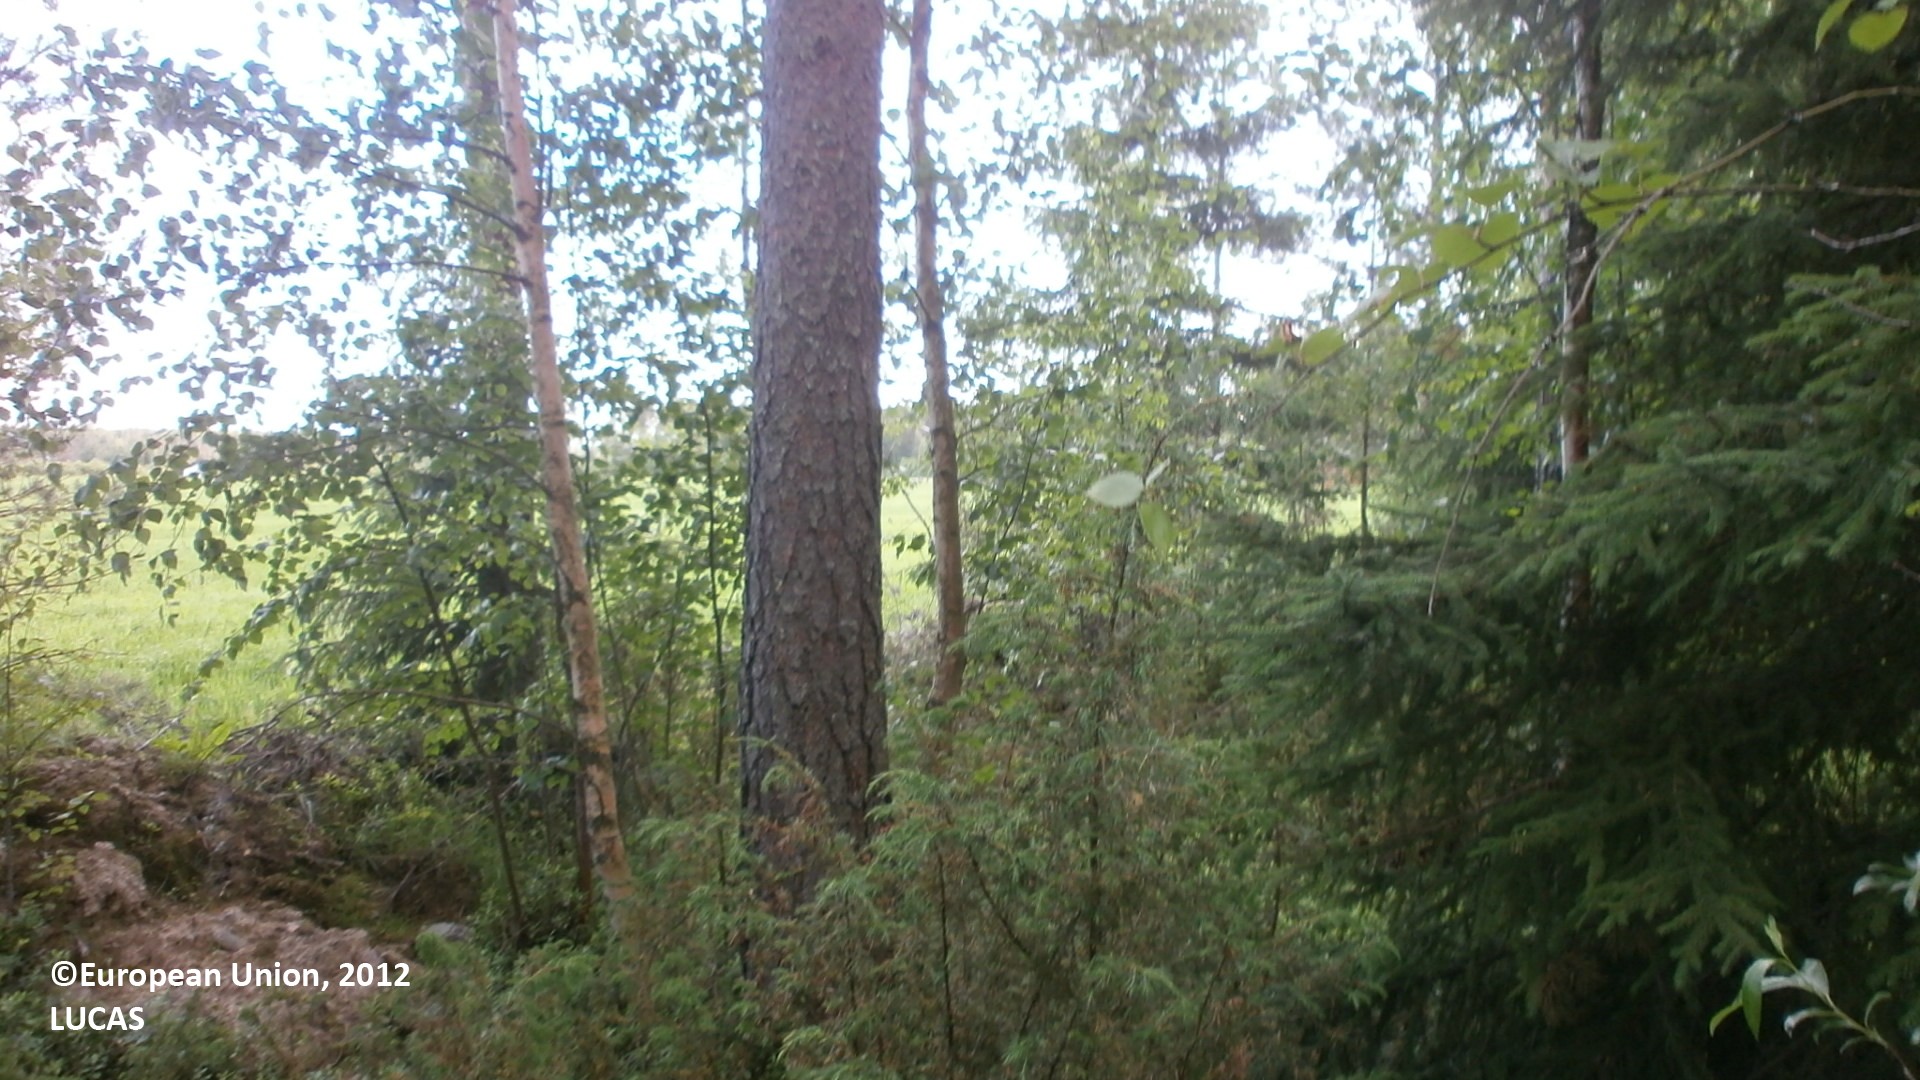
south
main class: Woodland
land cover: Pine dominated mixed woodland
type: boreal forest
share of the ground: > 75 %
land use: Forestry
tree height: > 5 m
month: July
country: FI
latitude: 63.9608
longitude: 24.7602
